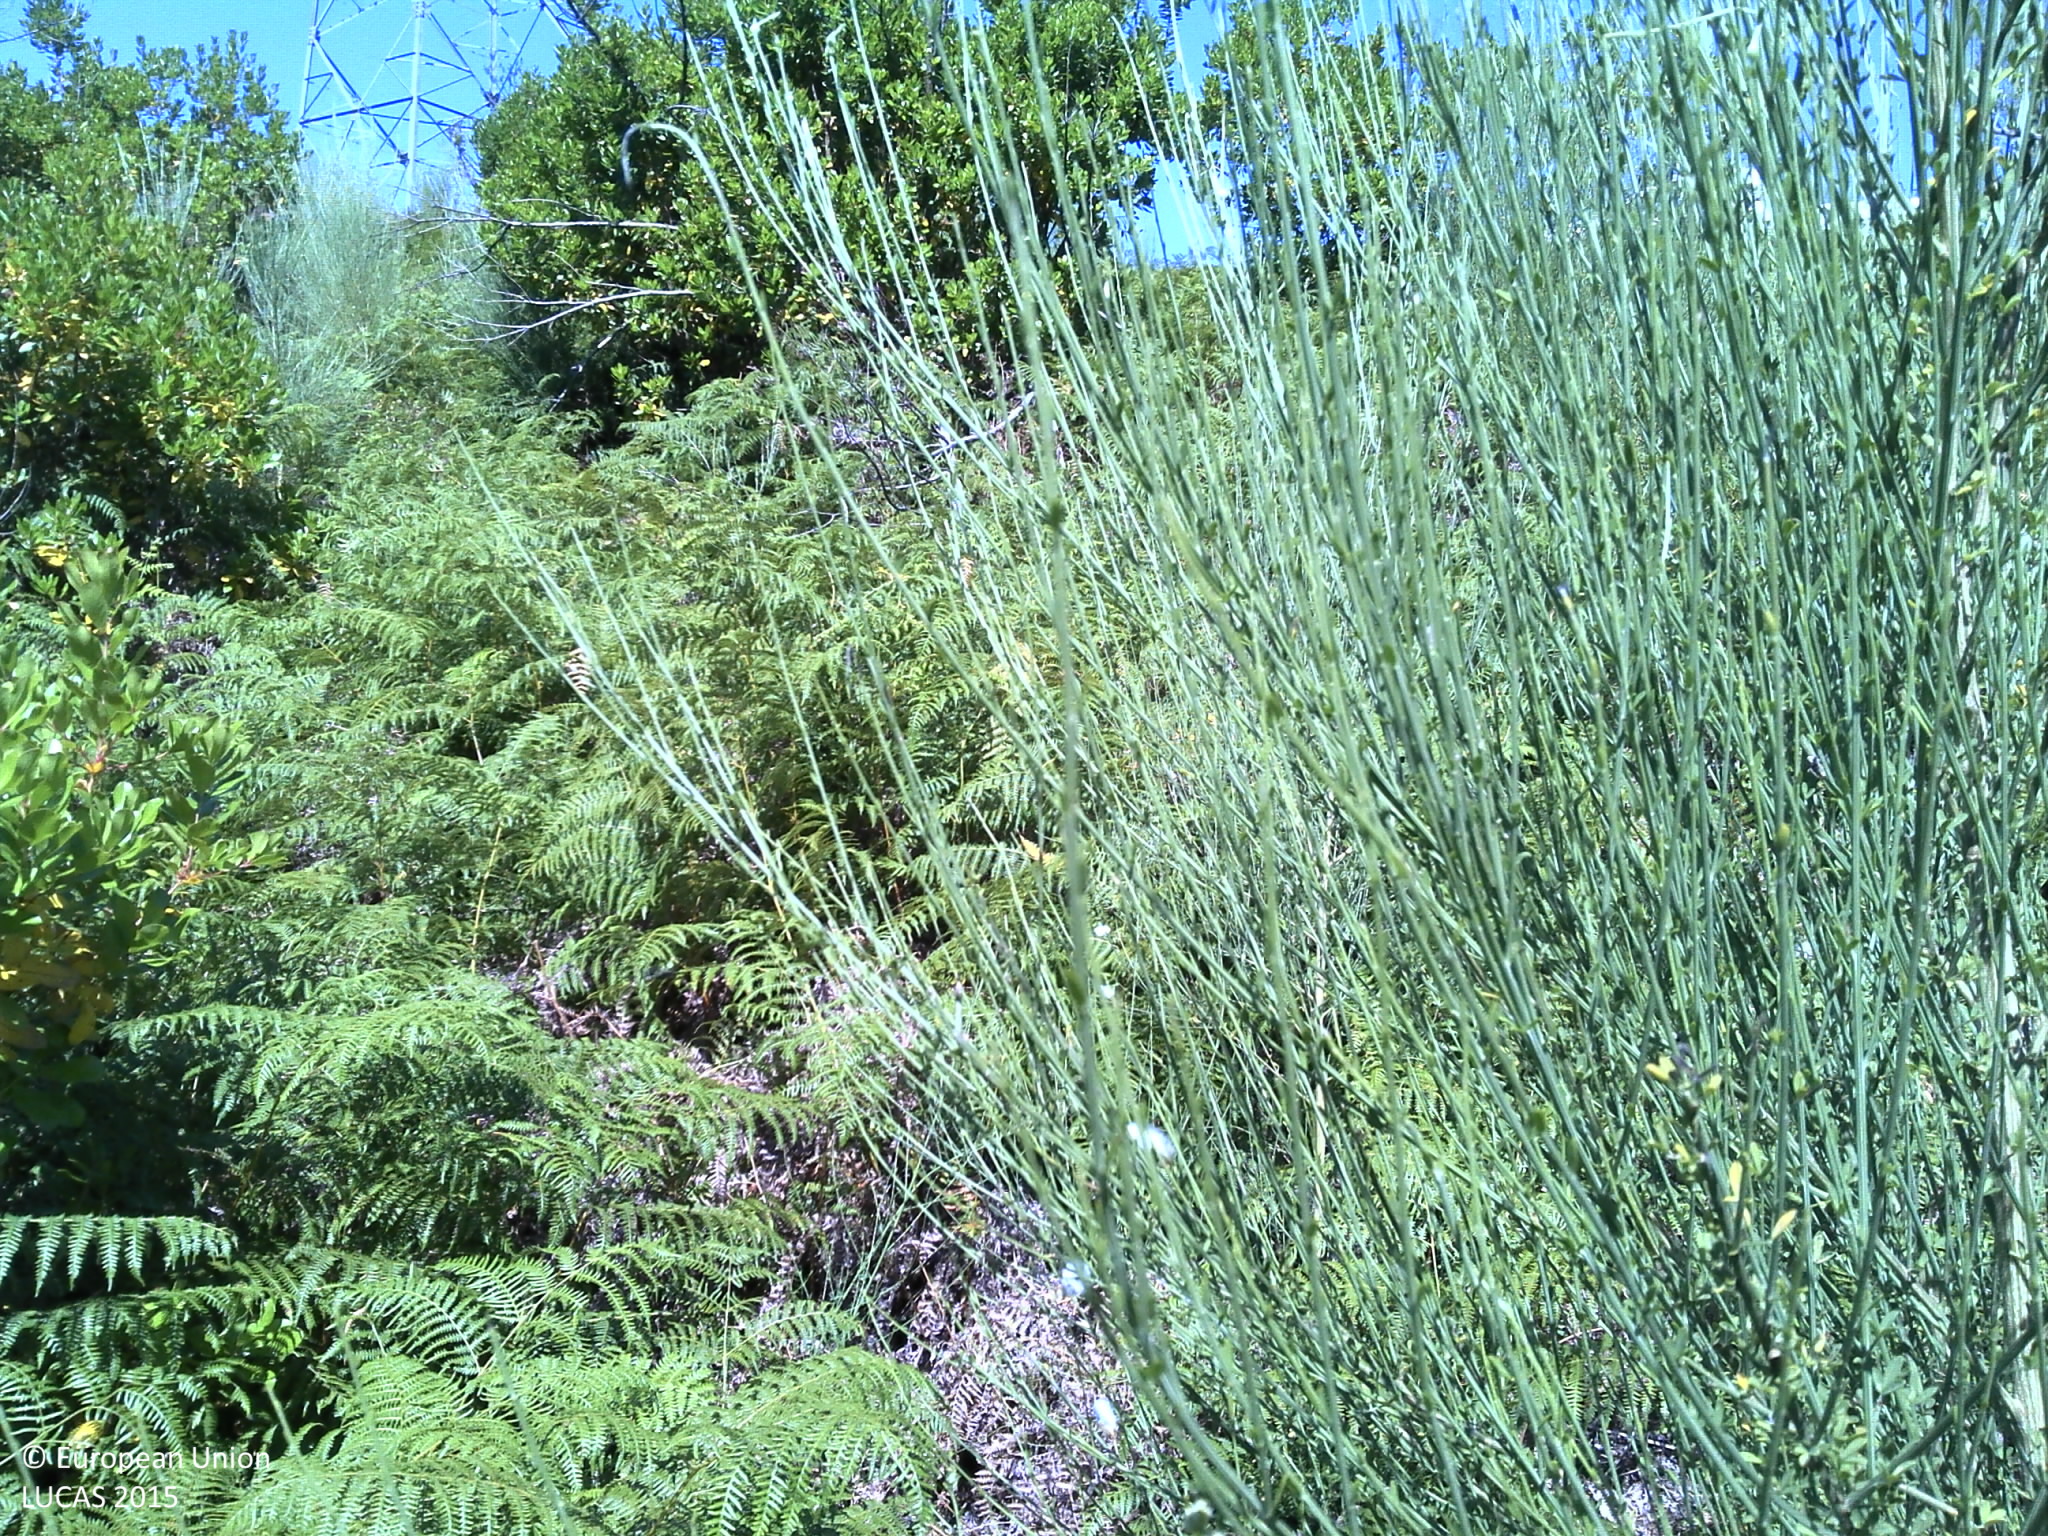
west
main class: Shrubland
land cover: Shrubland without tree cover
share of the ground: > 75 %
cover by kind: shrubs 75 %, herbaceous plants 10 %, consolidated bare surface 10 %, unconsolidated bare surface 5 %
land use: Semi-natural and natural areas not in use
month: June
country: PT
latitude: 41.8419
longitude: -8.2790
